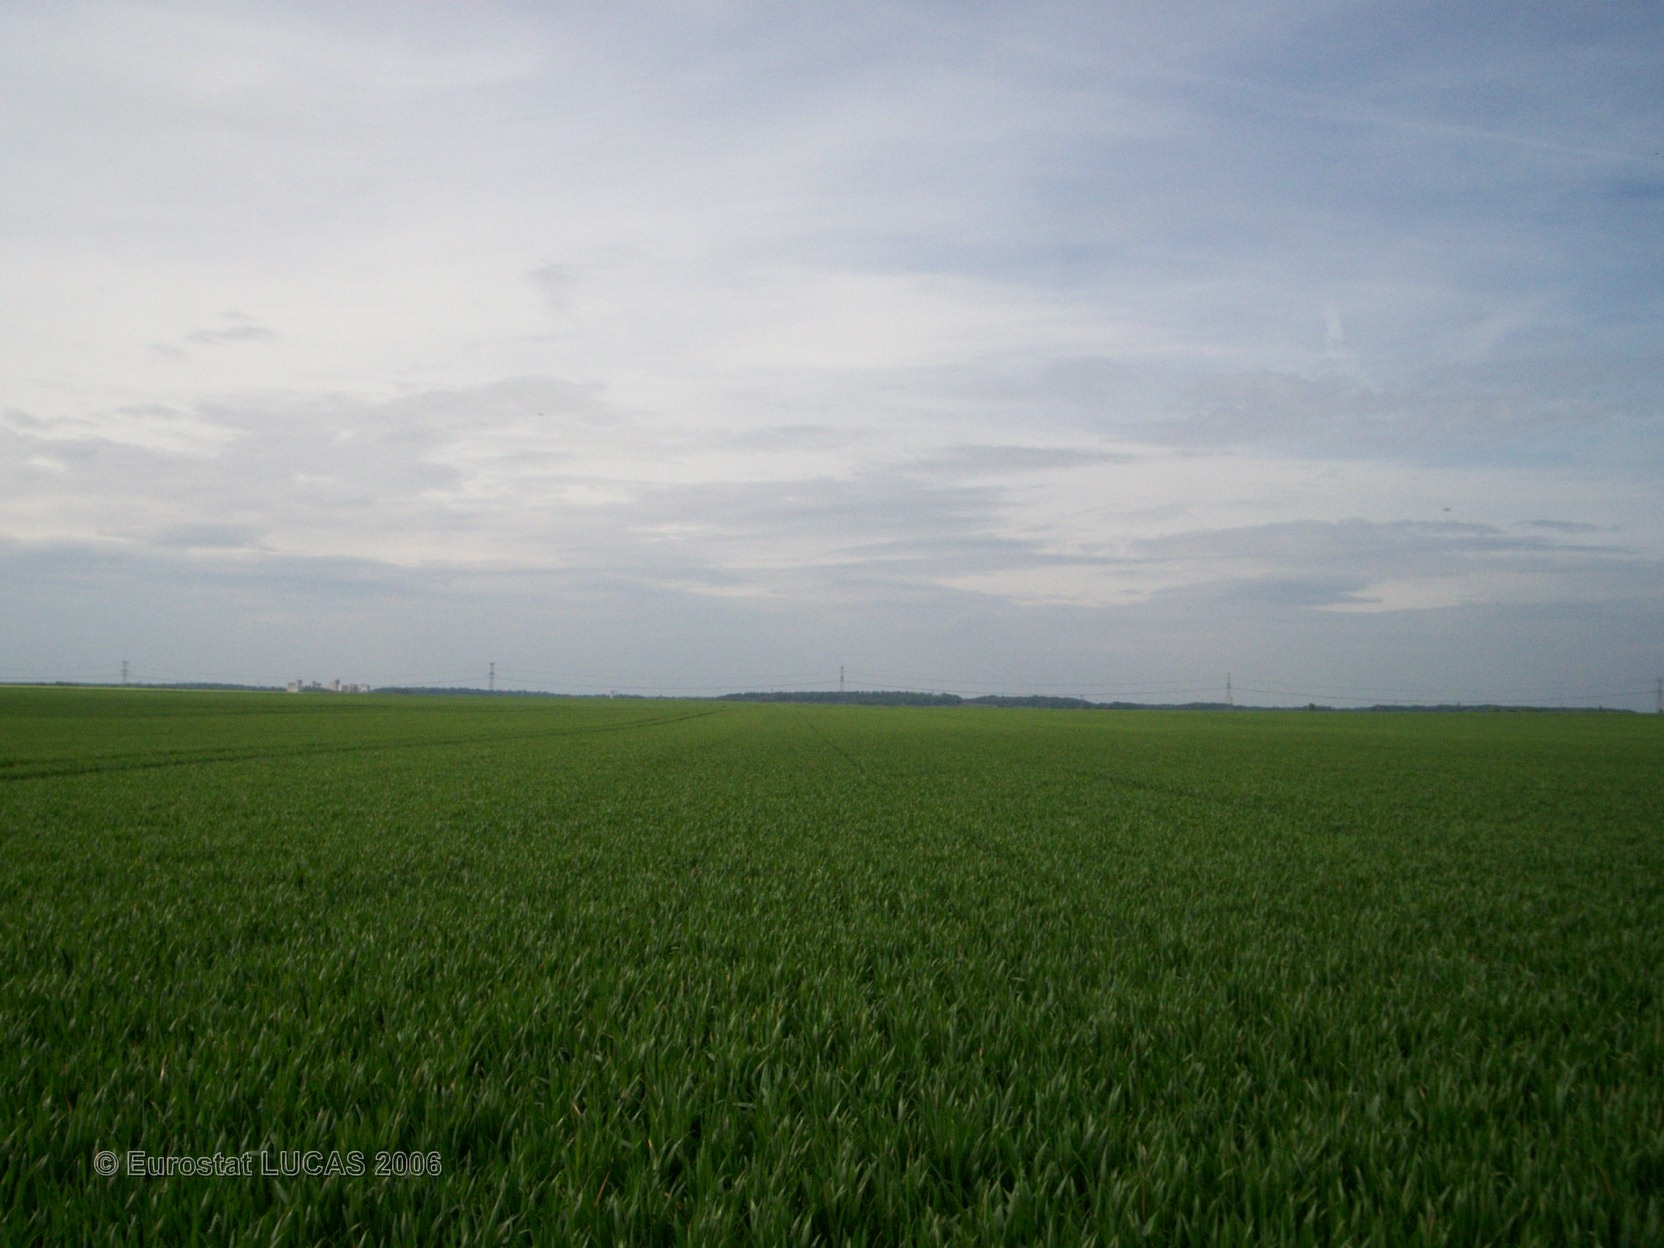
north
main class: Cropland
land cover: Common wheat
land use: Agriculture (excluding fallow land and kitchen gardens)
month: May
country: FR
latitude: 48.6050
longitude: 2.8439
